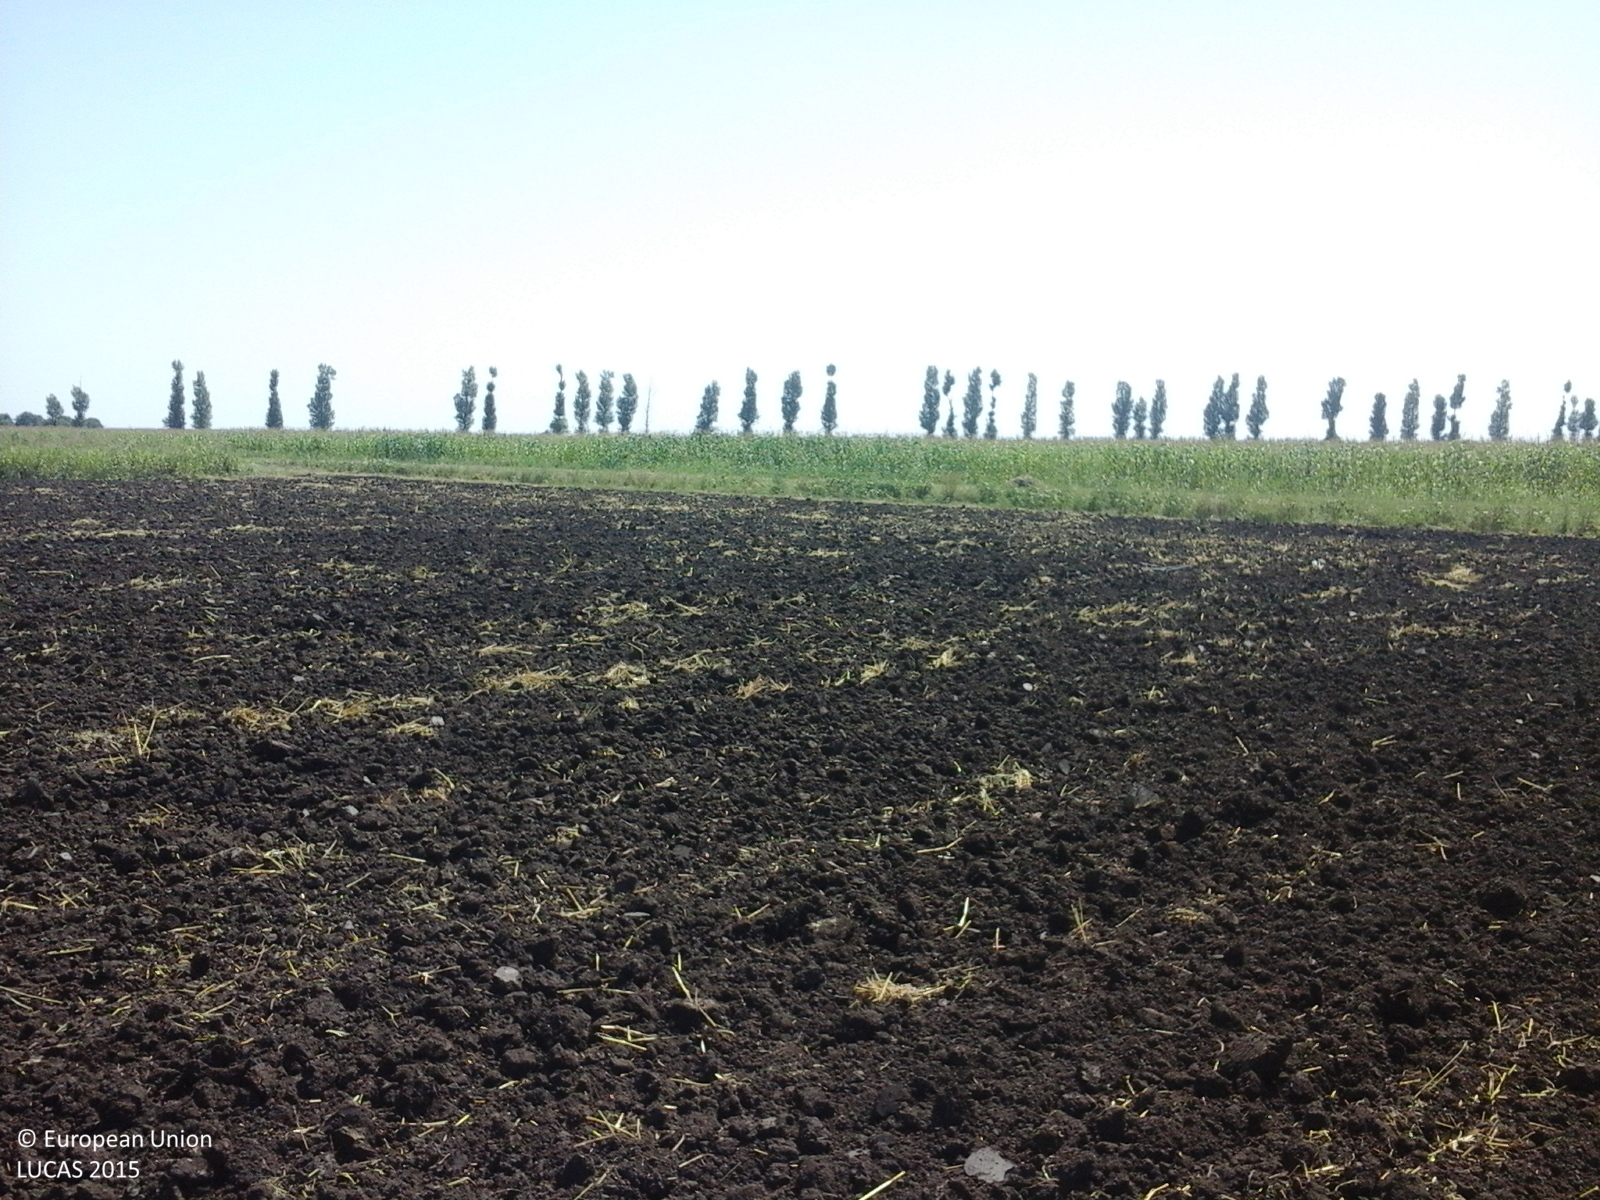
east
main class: Cropland
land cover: Maize
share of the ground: > 75 %
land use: Agriculture (excluding fallow land and kitchen gardens)
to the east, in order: Maize
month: July
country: RO
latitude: 44.9740
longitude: 26.5684
